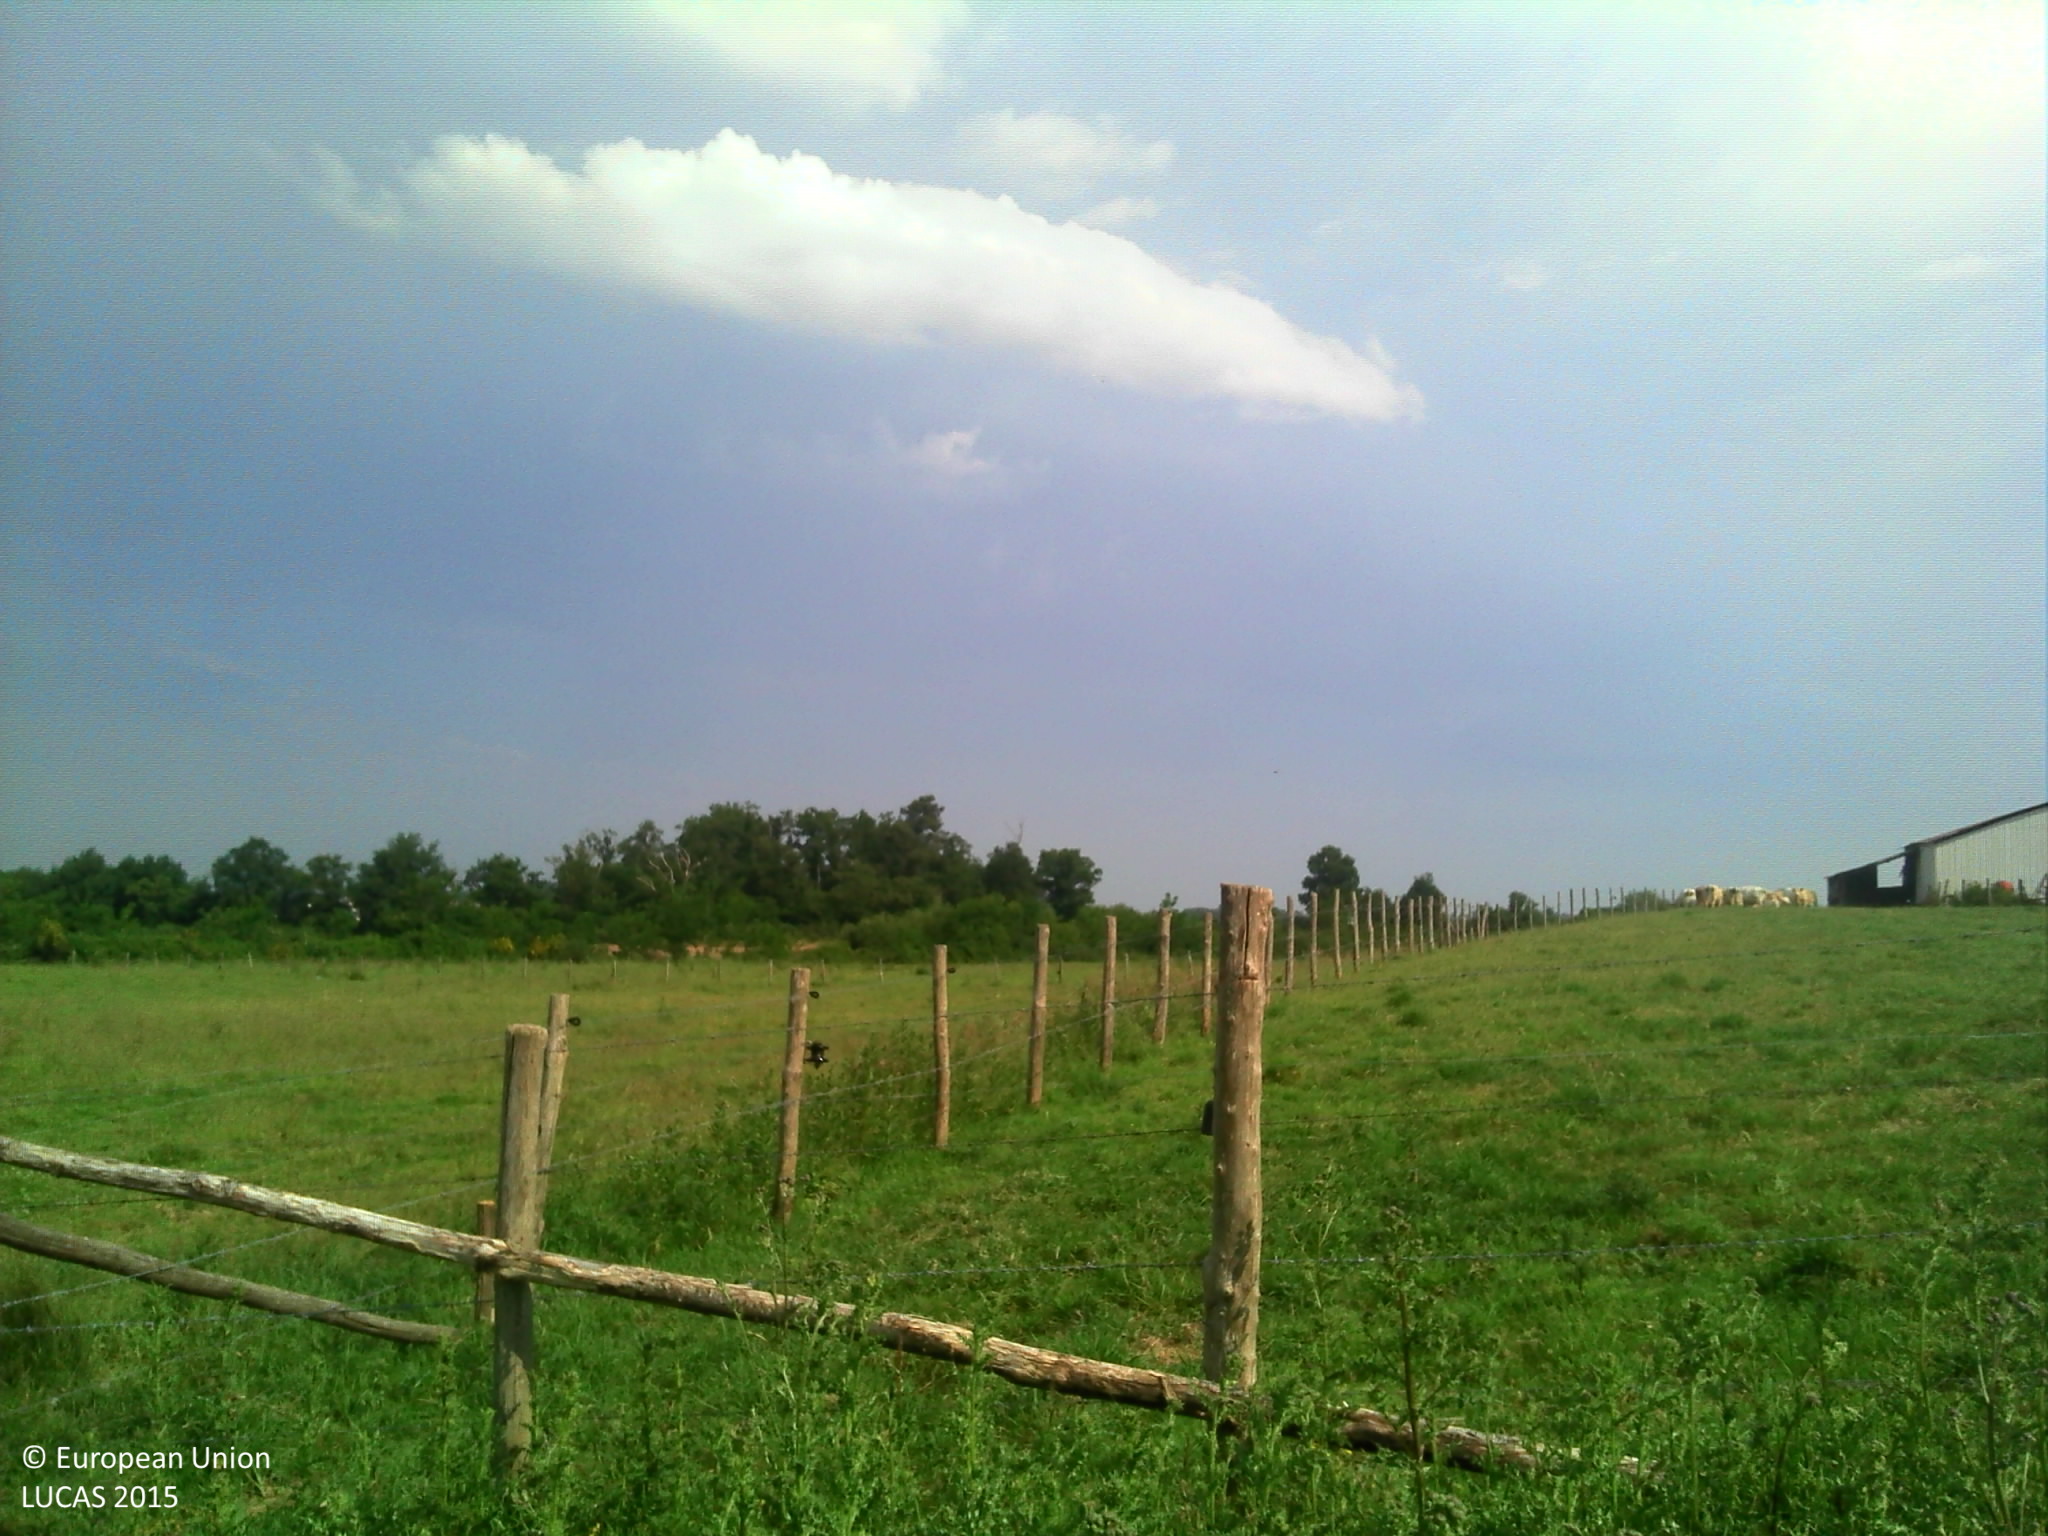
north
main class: Grassland
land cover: Grassland without tree/shrub cover
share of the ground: > 75 %
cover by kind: herbaceous plants 100 %
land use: Agriculture (excluding fallow land and kitchen gardens)
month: June
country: FR
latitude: 47.8929
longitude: -0.0189
